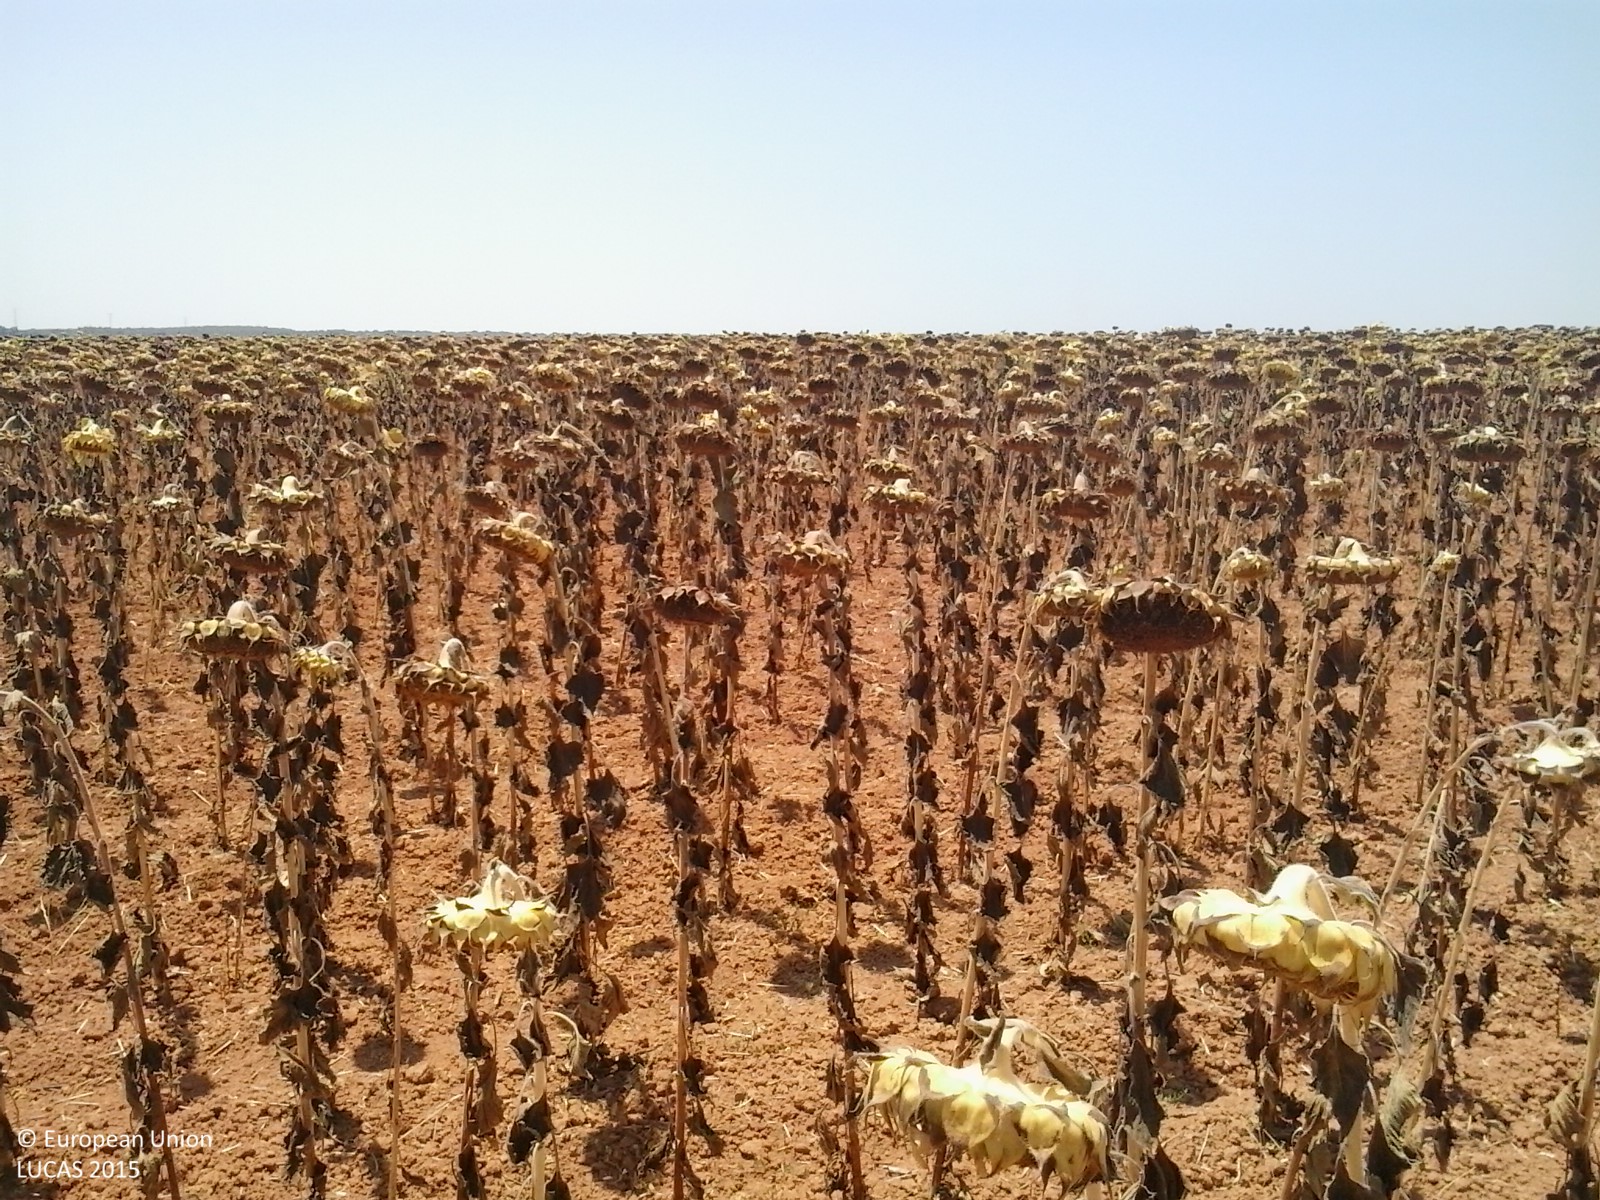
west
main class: Cropland
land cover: Sunflower
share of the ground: 25 - 50 %
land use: Agriculture (excluding fallow land and kitchen gardens)
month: July
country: ES
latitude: 37.4727
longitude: -6.4171
